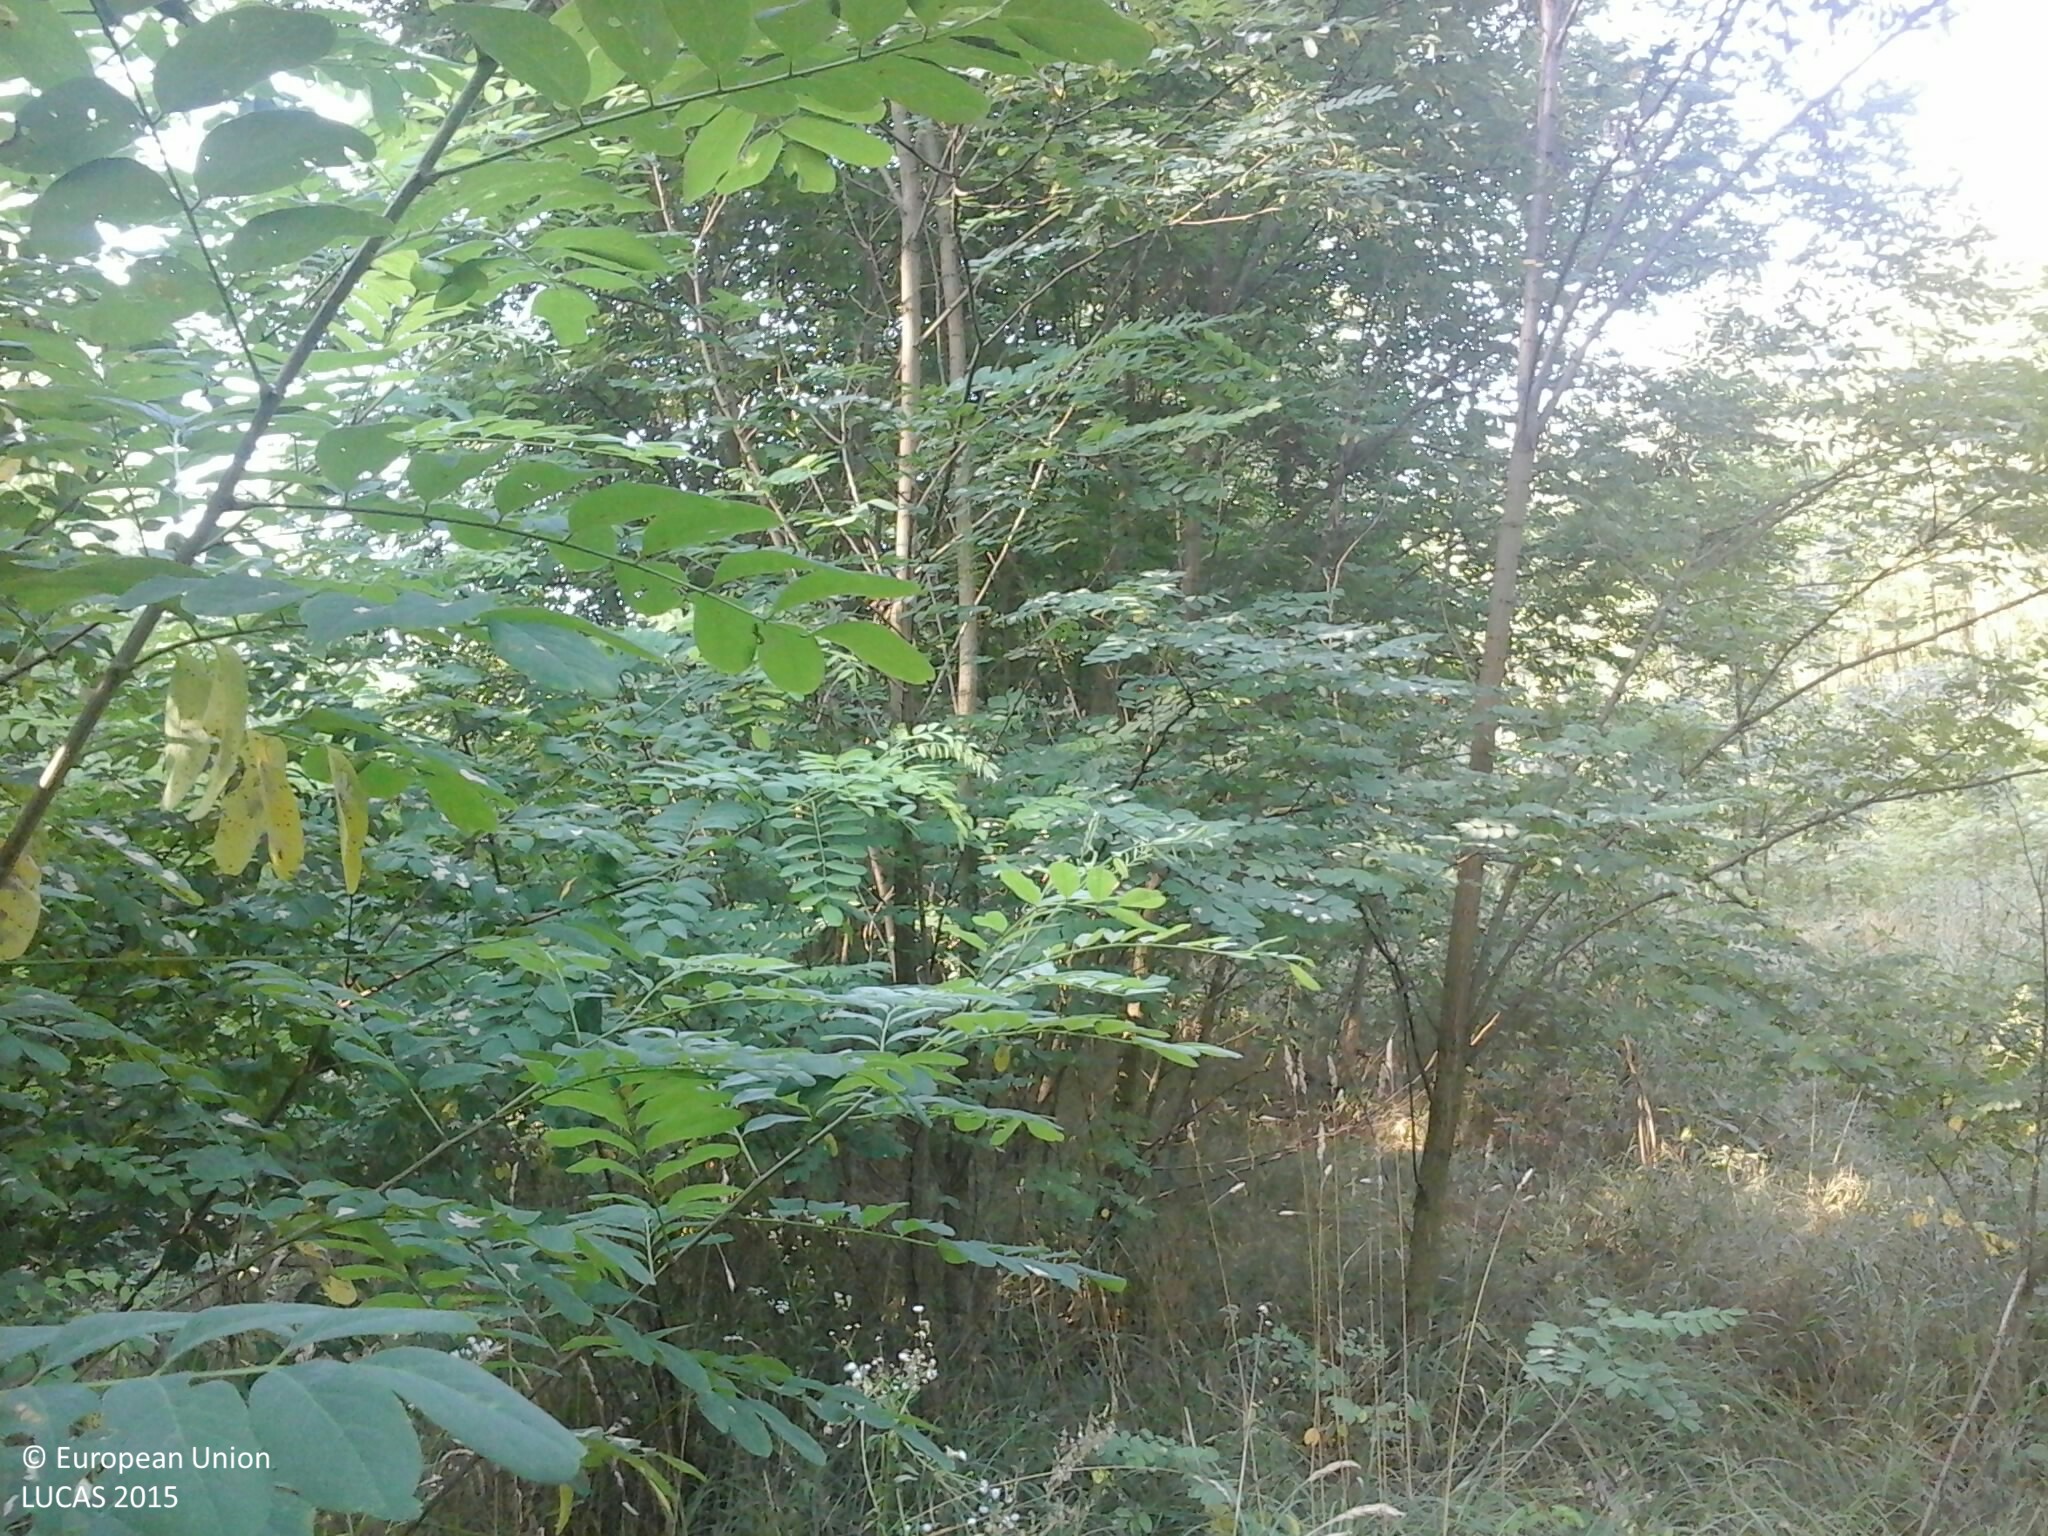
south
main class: Woodland
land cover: Broadleaved woodland
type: exotic forest
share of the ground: > 75 %
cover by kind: broadleaved forest trees 80 %, shrubs 10 %, herbaceous plants 10 %
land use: Forestry
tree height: > 5 m
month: July
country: HU
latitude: 47.8017
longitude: 22.3261
